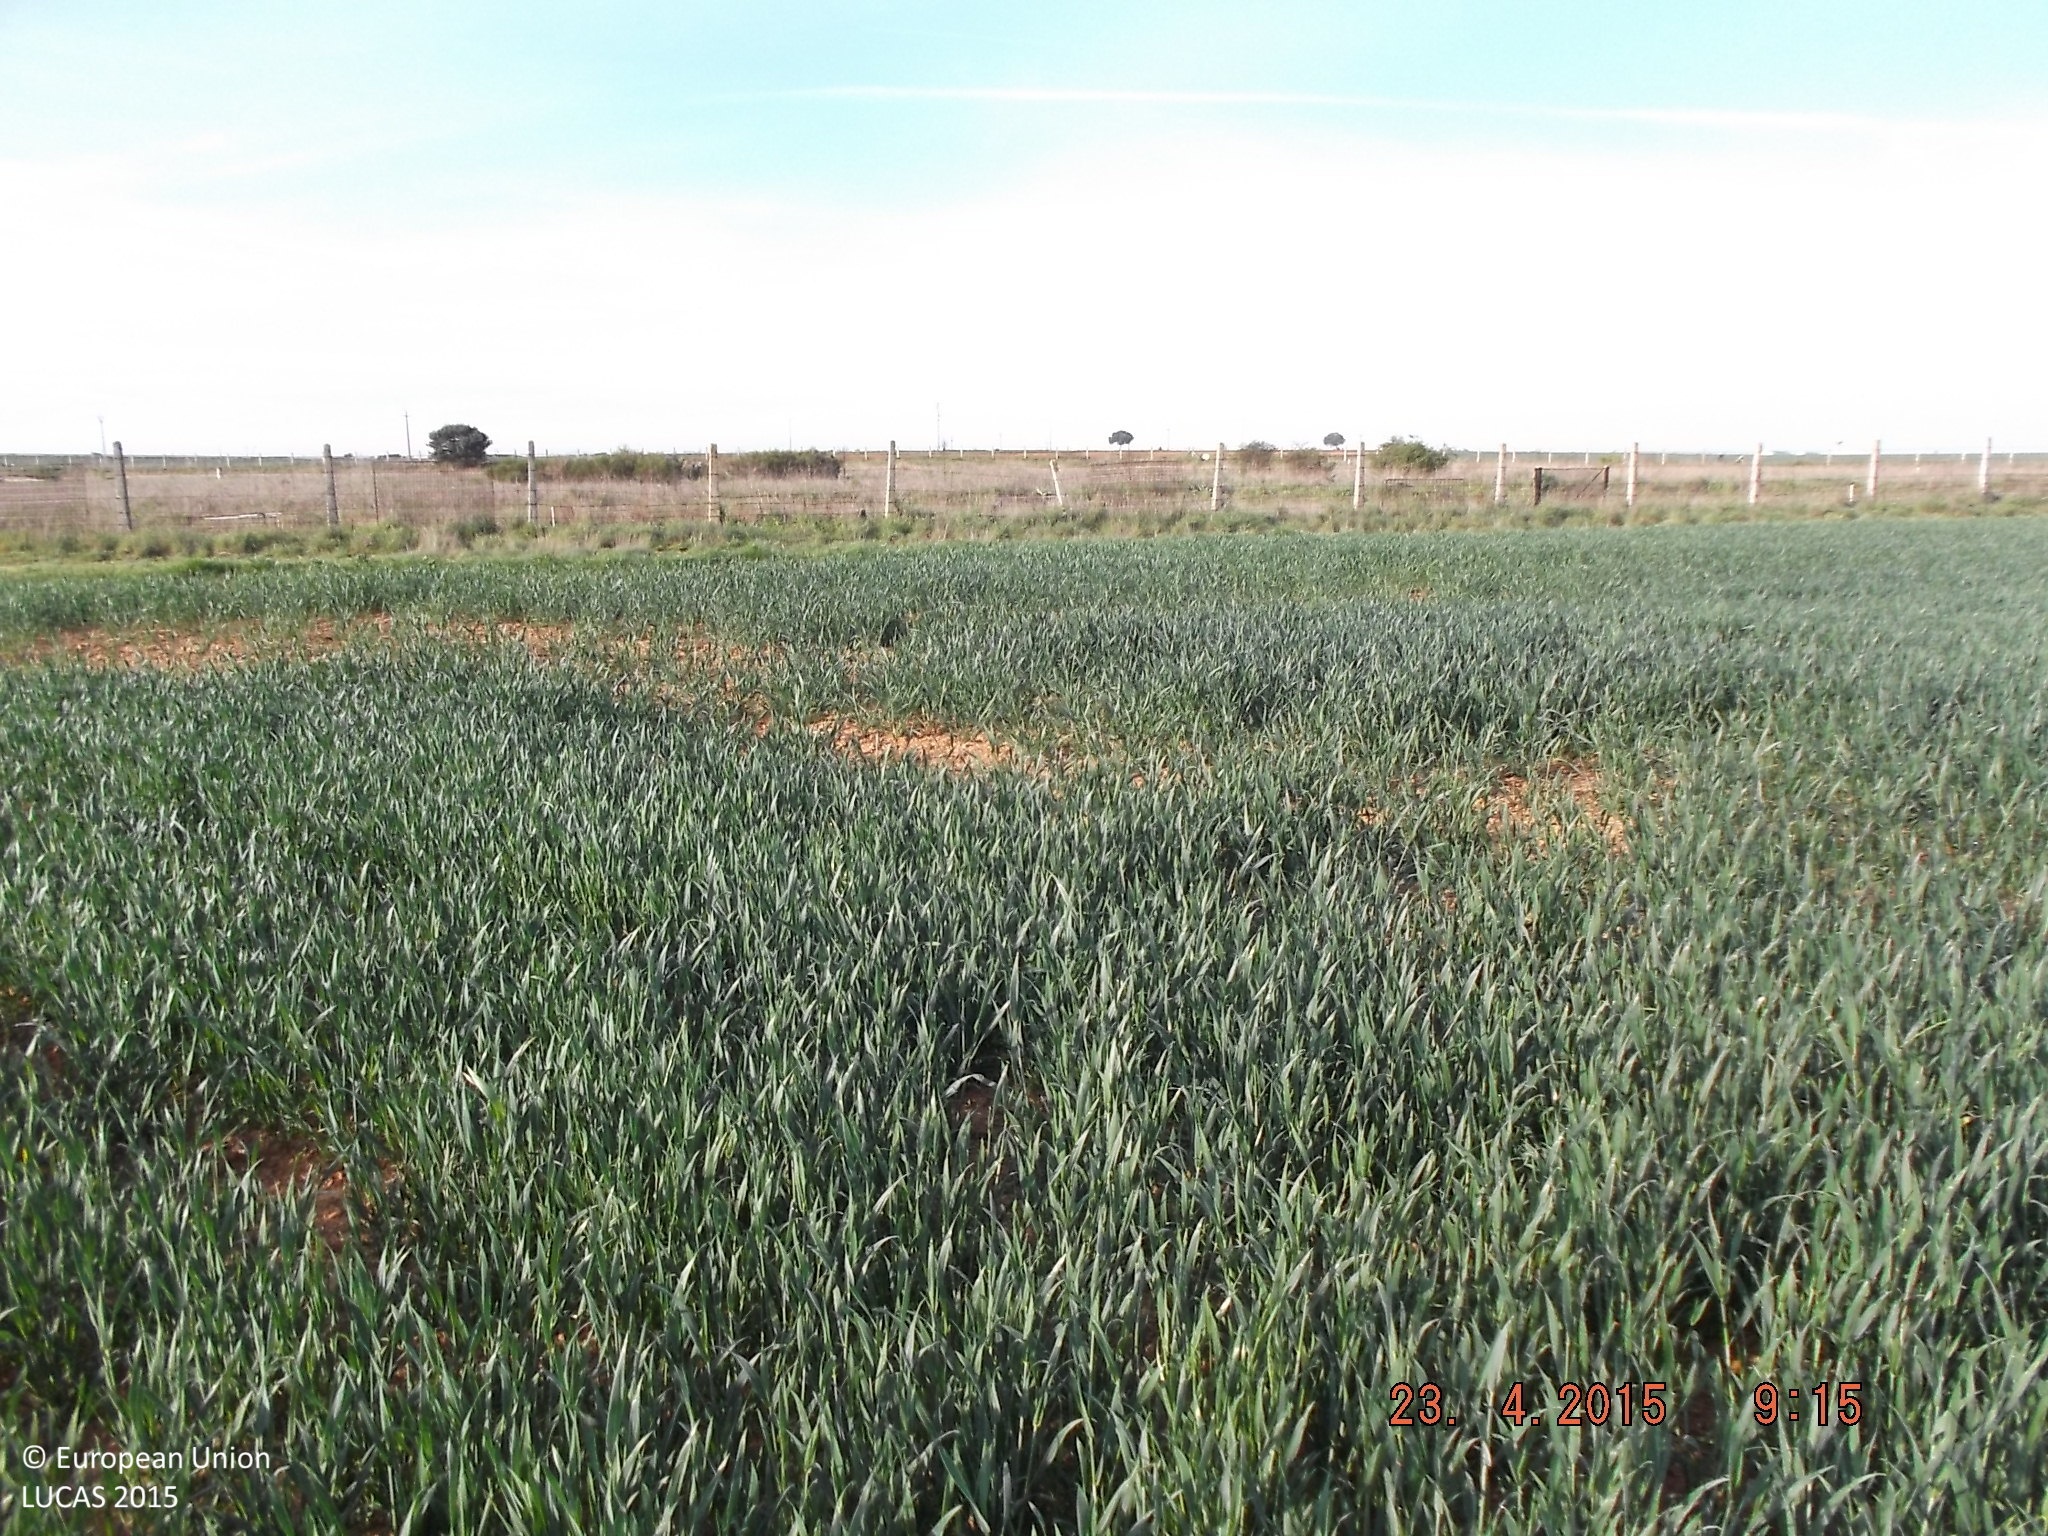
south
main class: Cropland
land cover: Common wheat
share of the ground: > 75 %
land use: Agriculture (excluding fallow land and kitchen gardens)
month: April
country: ES
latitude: 40.9135
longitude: -5.8838
